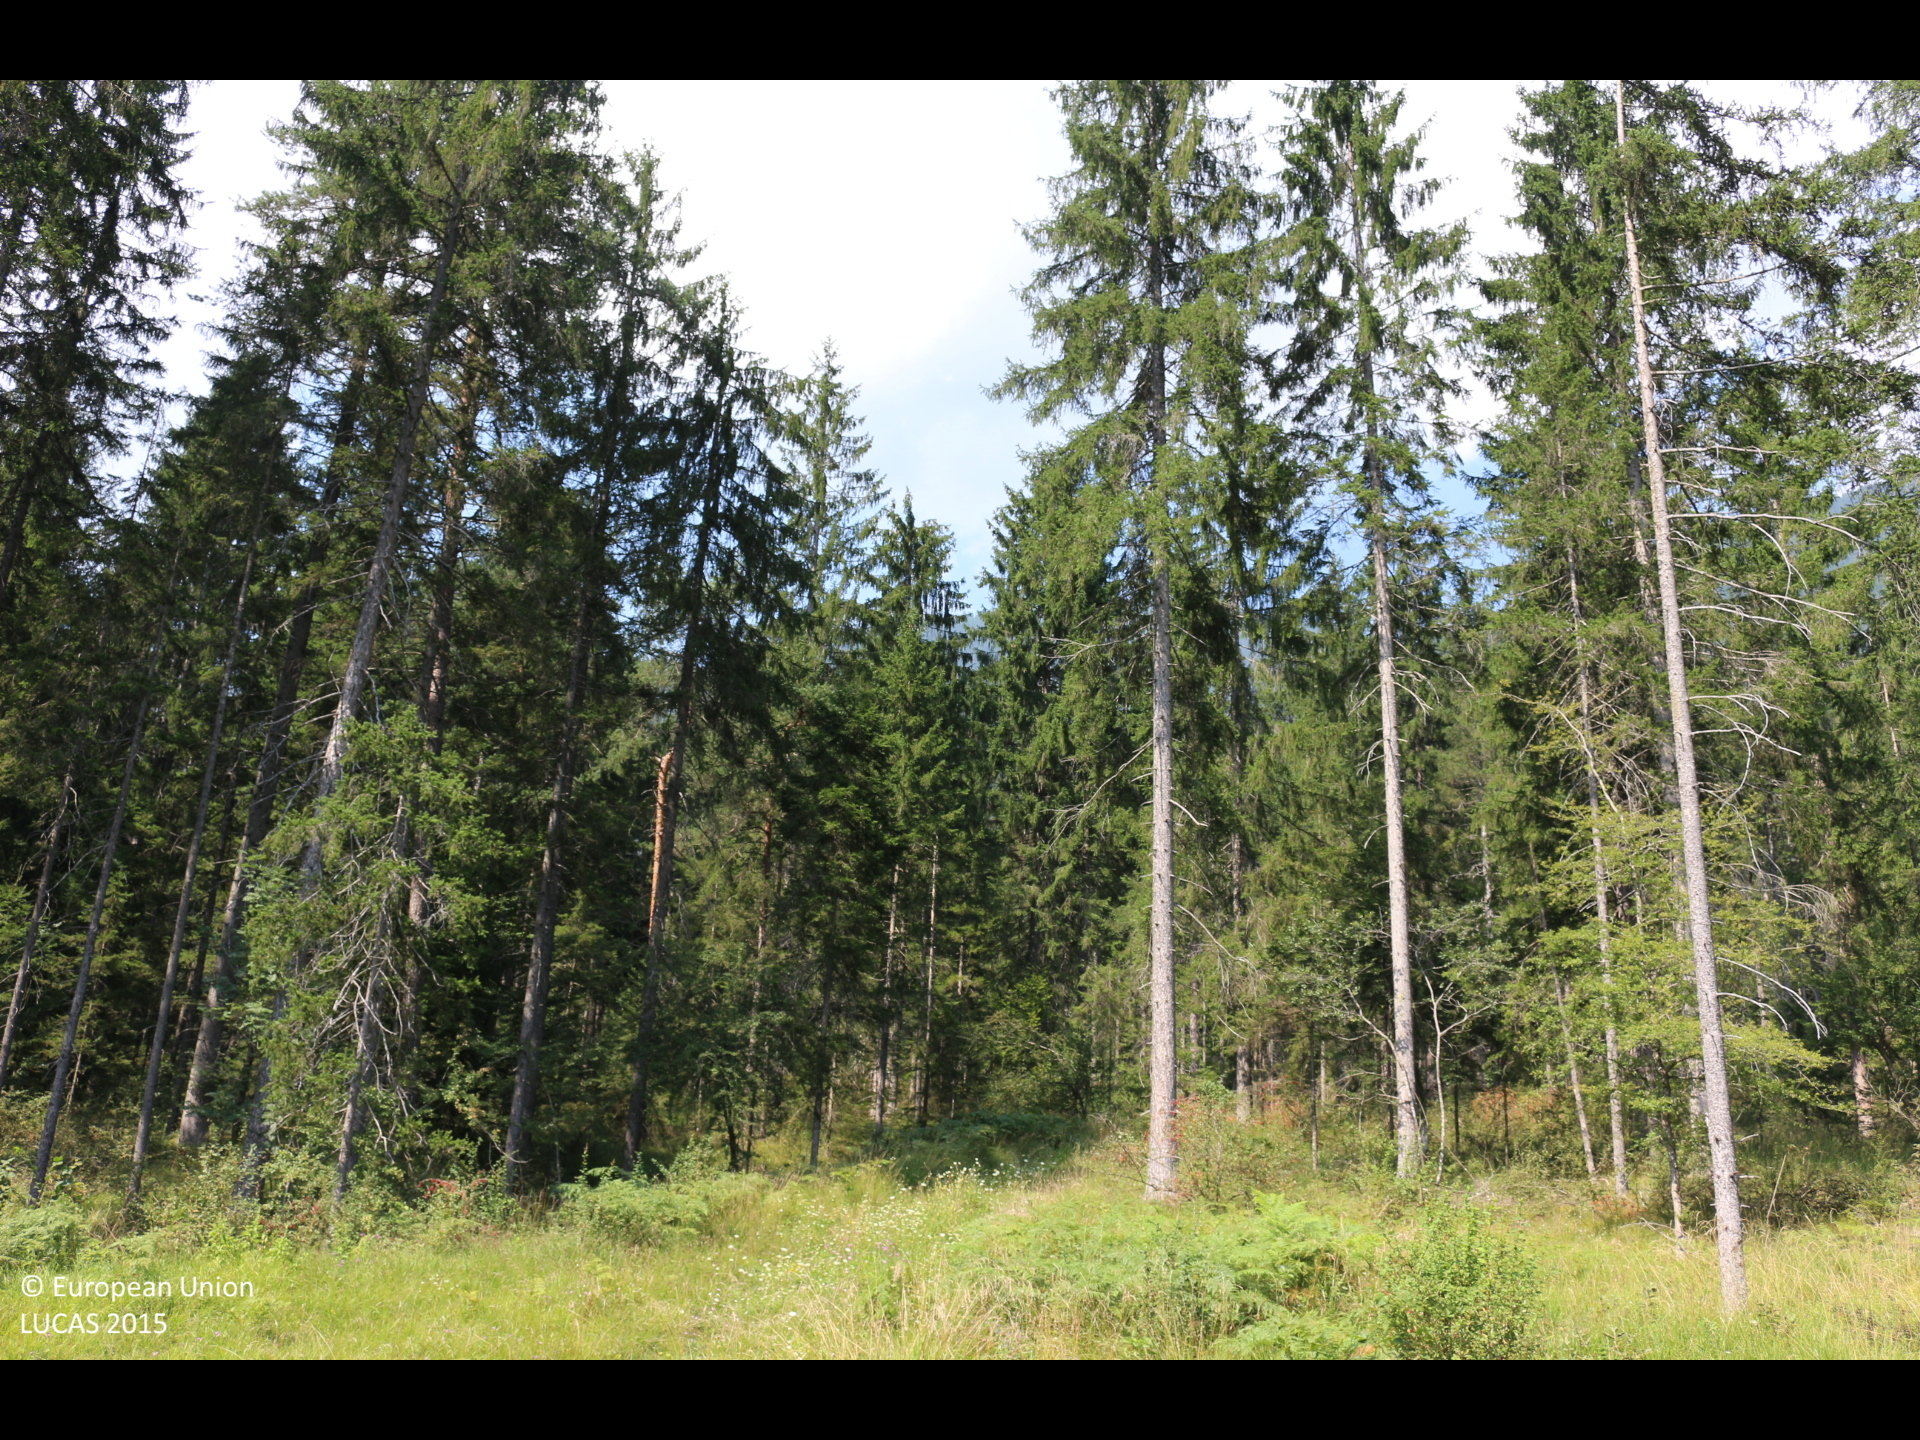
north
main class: Grassland
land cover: Grassland without tree/shrub cover
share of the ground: > 75 %
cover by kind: herbaceous plants 95 %, shrubs 5 %
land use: Forestry
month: August
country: AT
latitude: 46.6403
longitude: 13.3807
